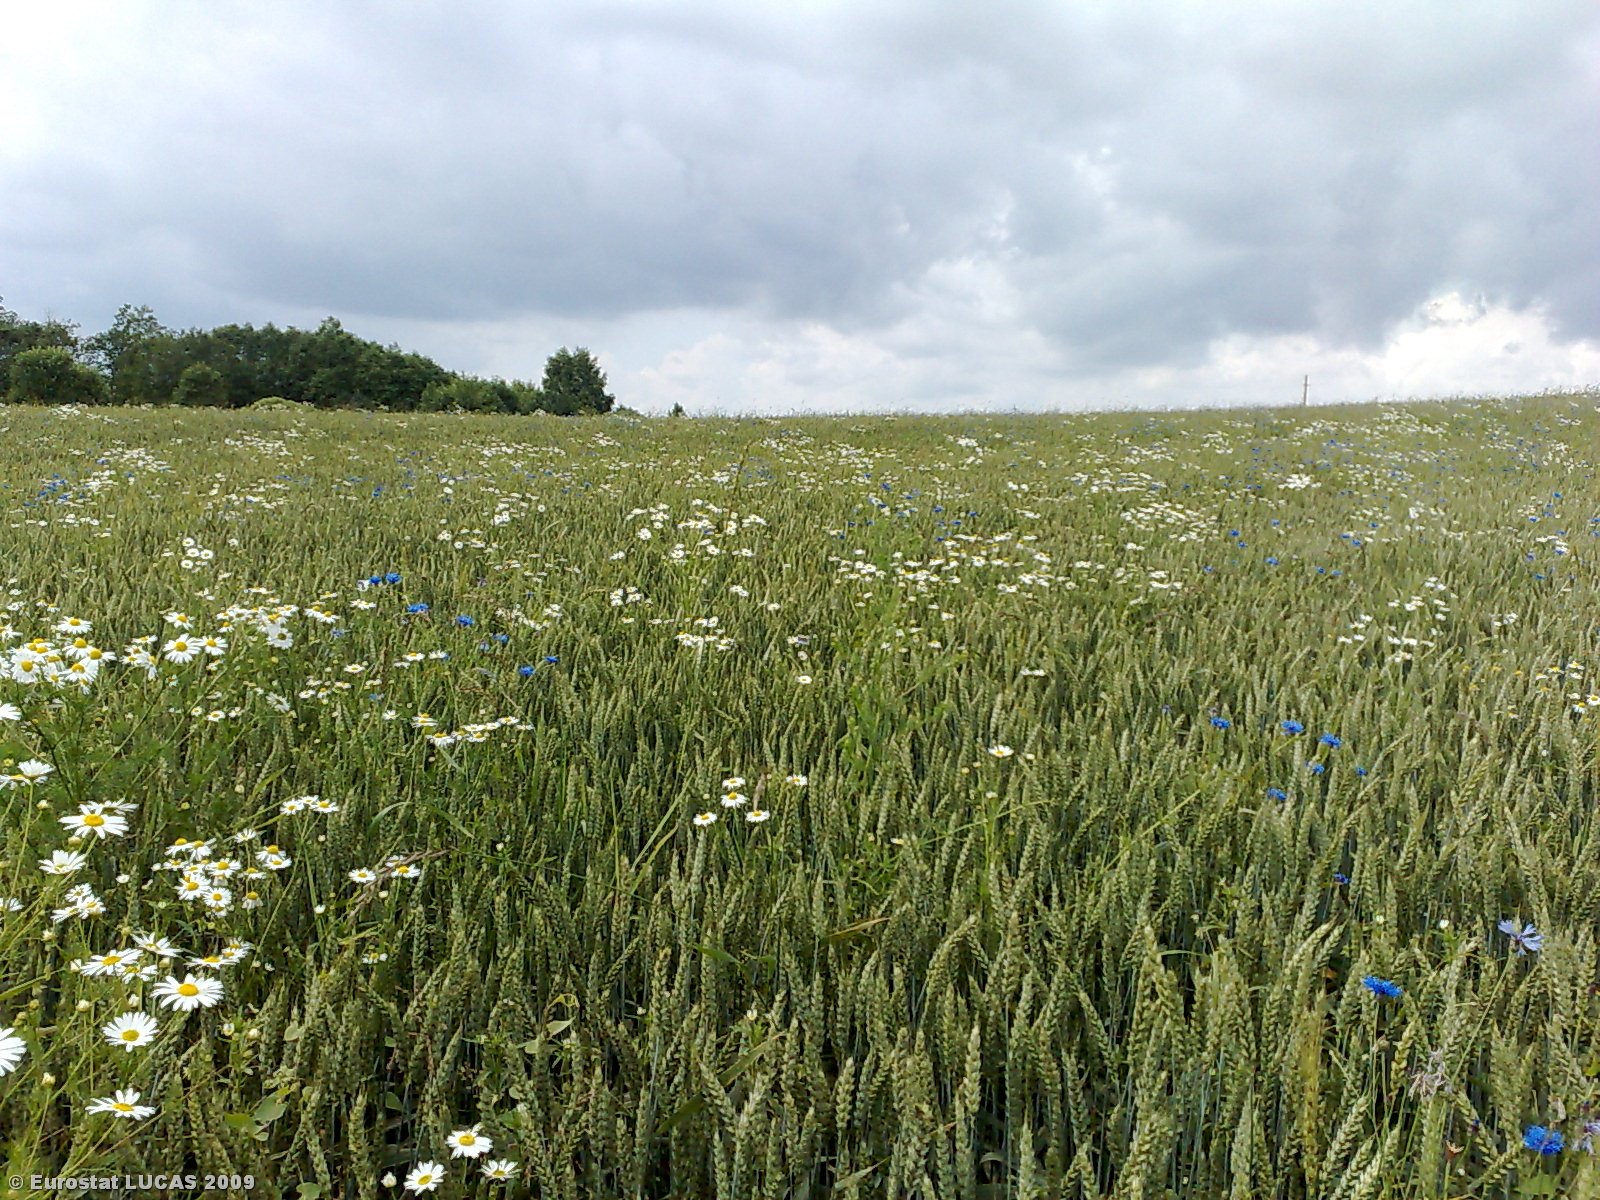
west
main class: Cropland
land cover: Common wheat
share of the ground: > 75 %
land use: Agriculture (excluding fallow land and kitchen gardens)
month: July
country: LT
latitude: 55.6179
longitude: 22.7839
